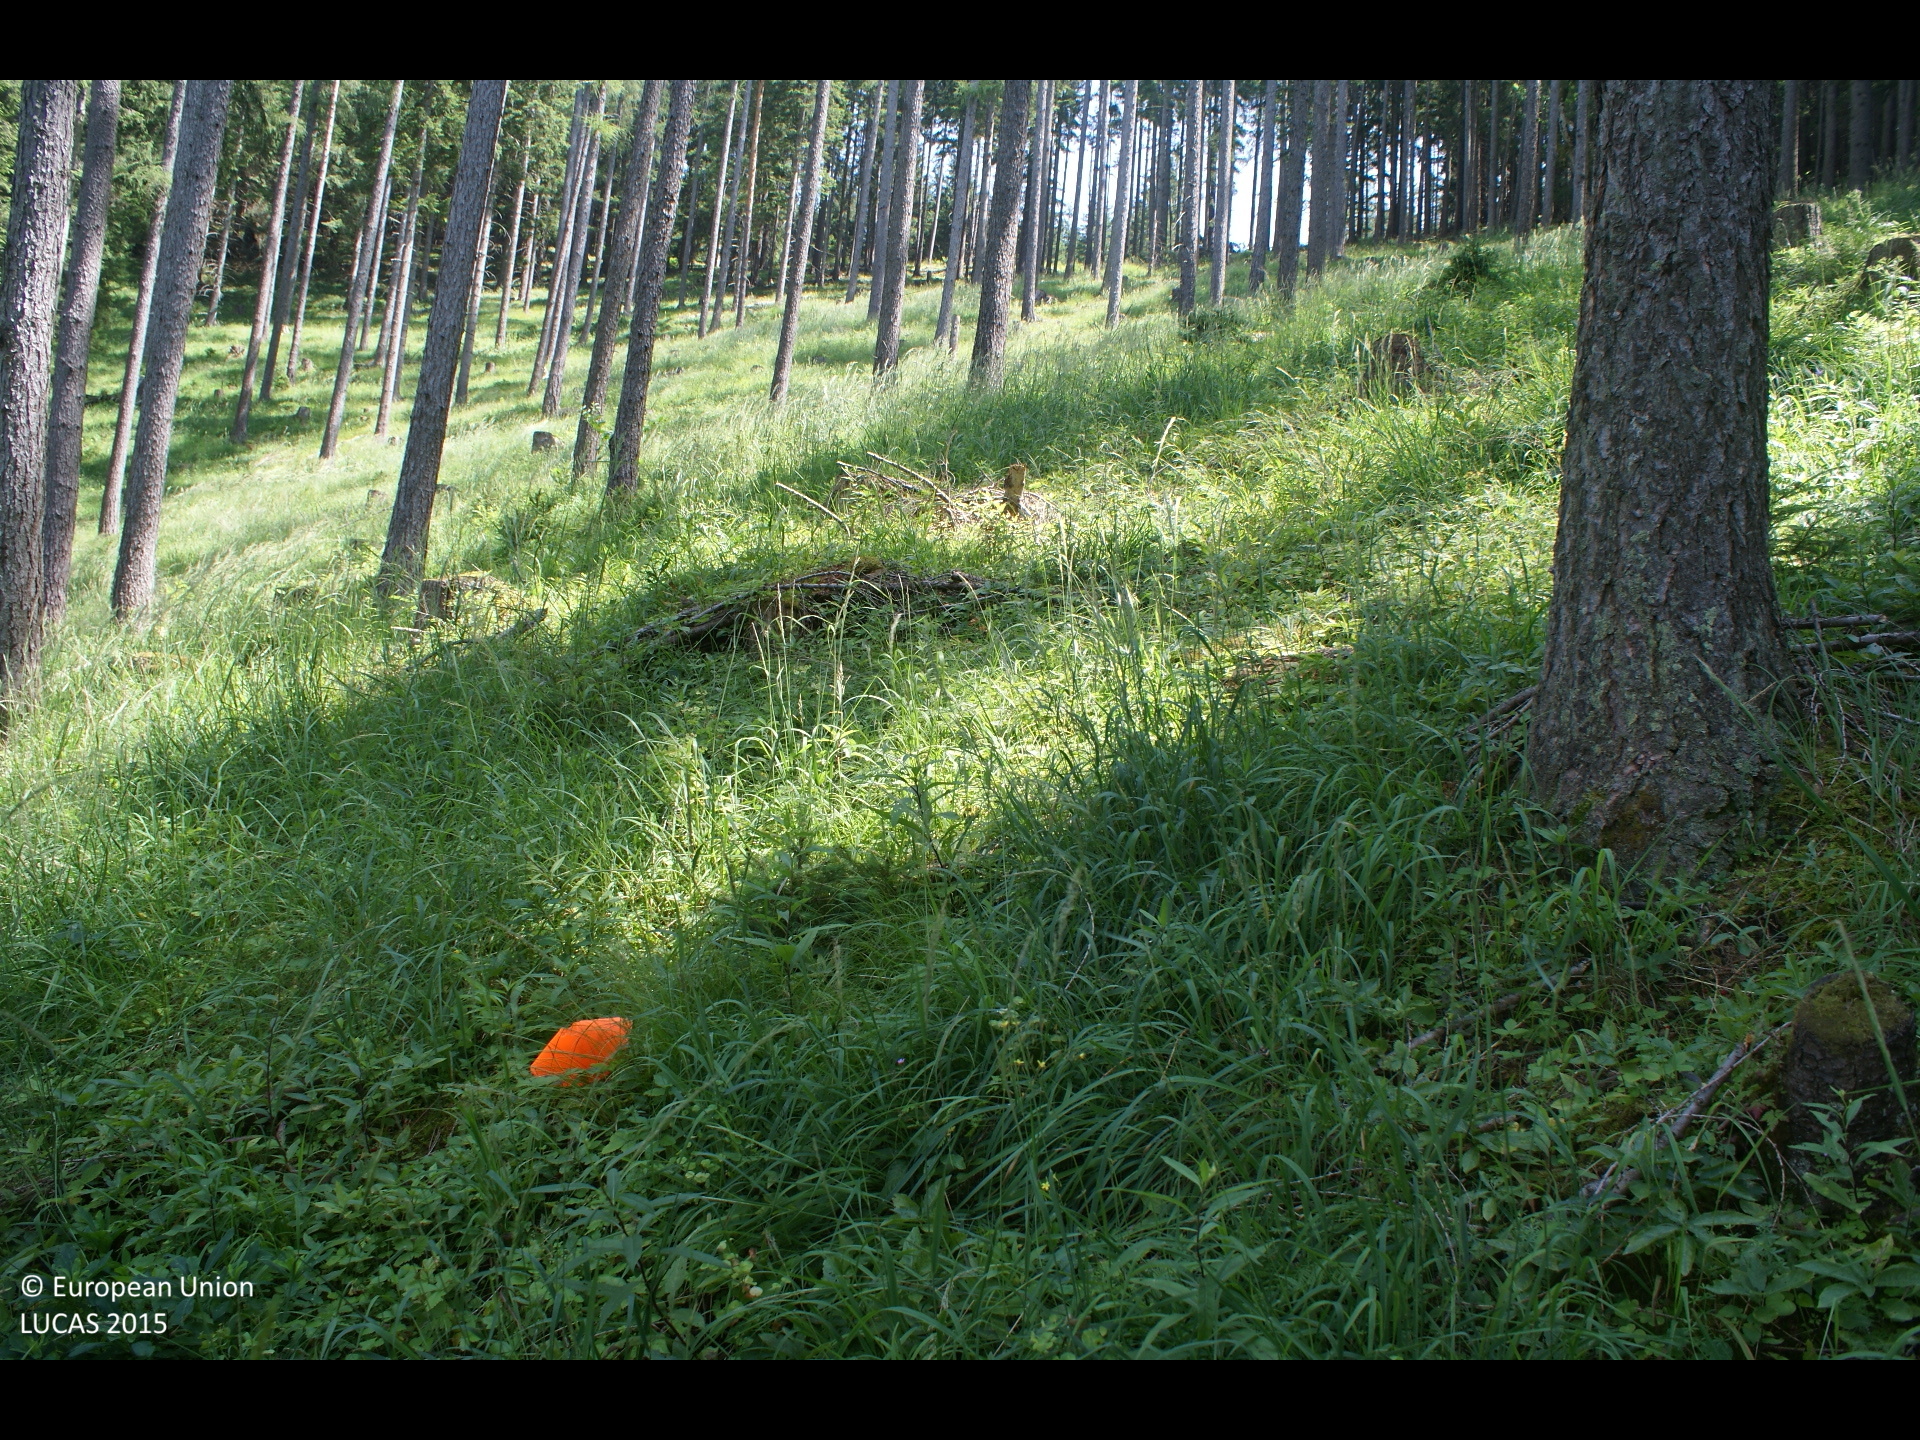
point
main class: Woodland
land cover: Other coniferous woodland
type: alpine coniferous forest
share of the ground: > 75 %
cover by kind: coniferous forest trees 75 %, herbaceous plants 20 %, shrubs 5 %
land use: Forestry
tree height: > 5 m
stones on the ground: < 10 %
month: July
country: AT
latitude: 47.8433
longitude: 15.3060
